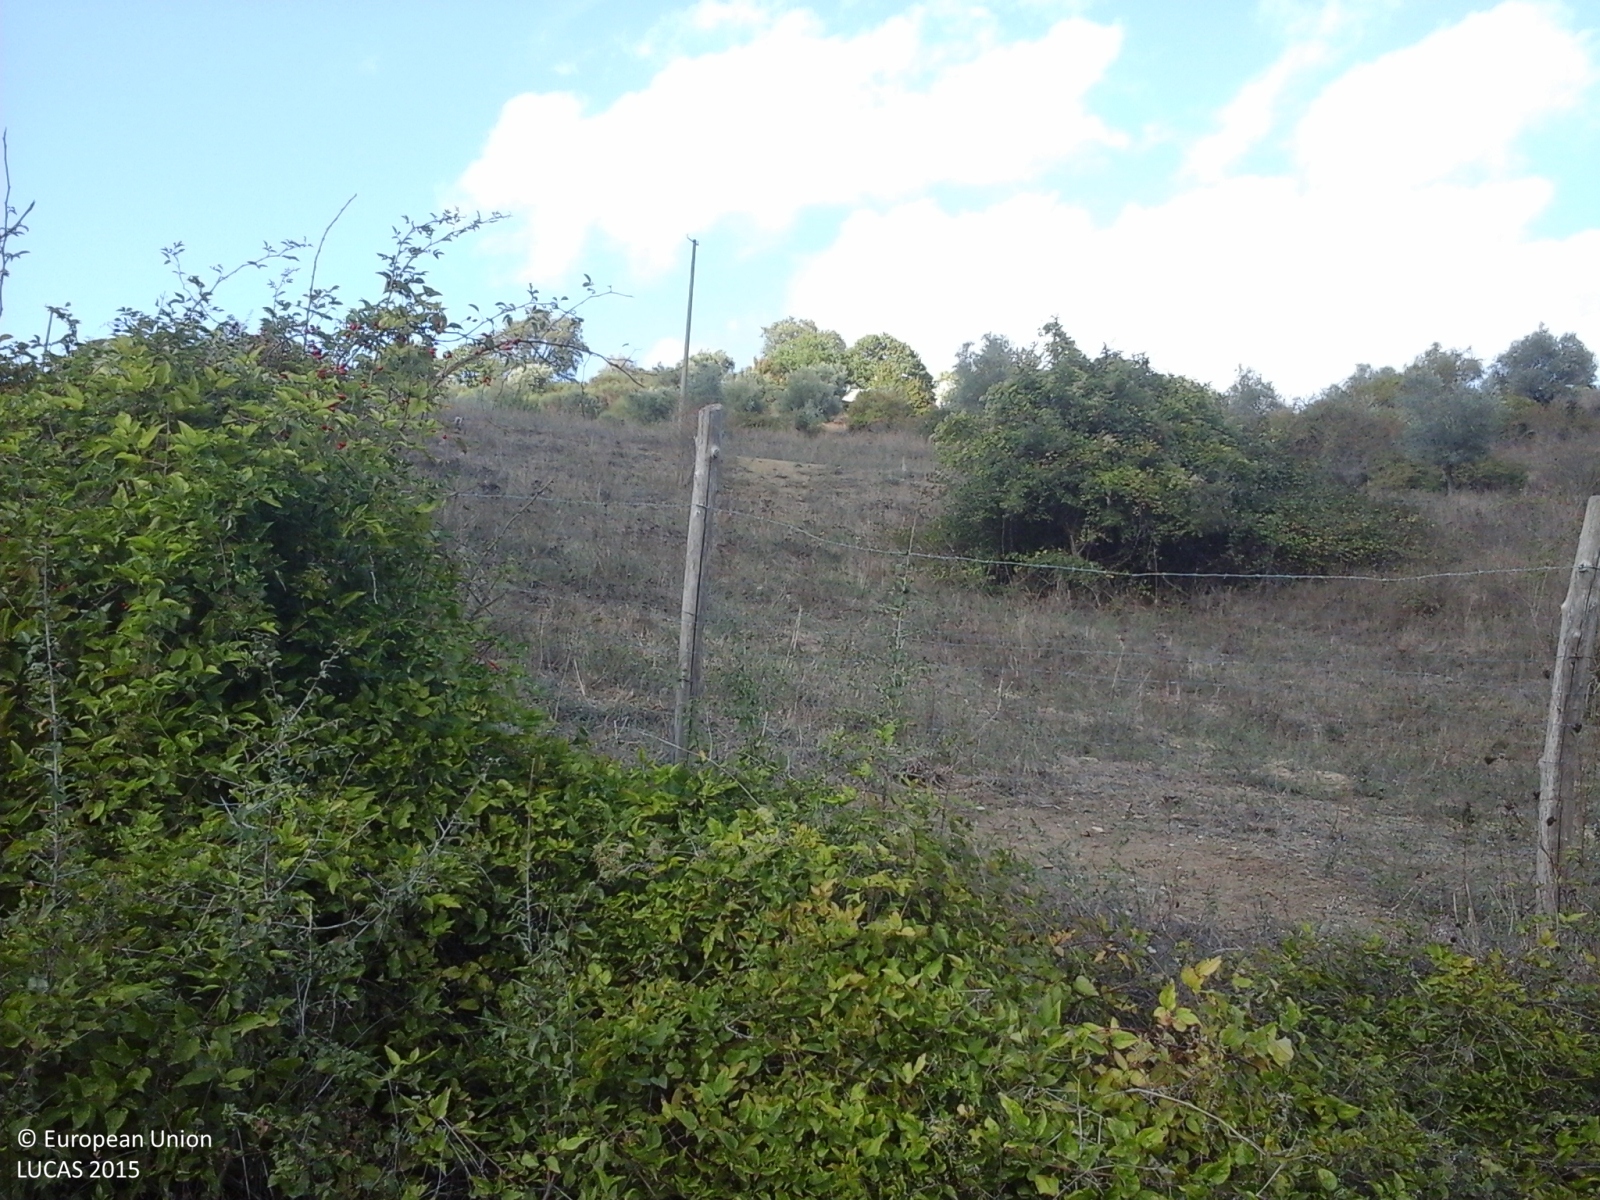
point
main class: Cropland
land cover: Olive groves
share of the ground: 25 - 50 %
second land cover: Grassland without tree/shrub cover
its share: > 75 %
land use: Agriculture (excluding fallow land and kitchen gardens)
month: October
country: IT
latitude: 43.2427
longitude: 12.2719
